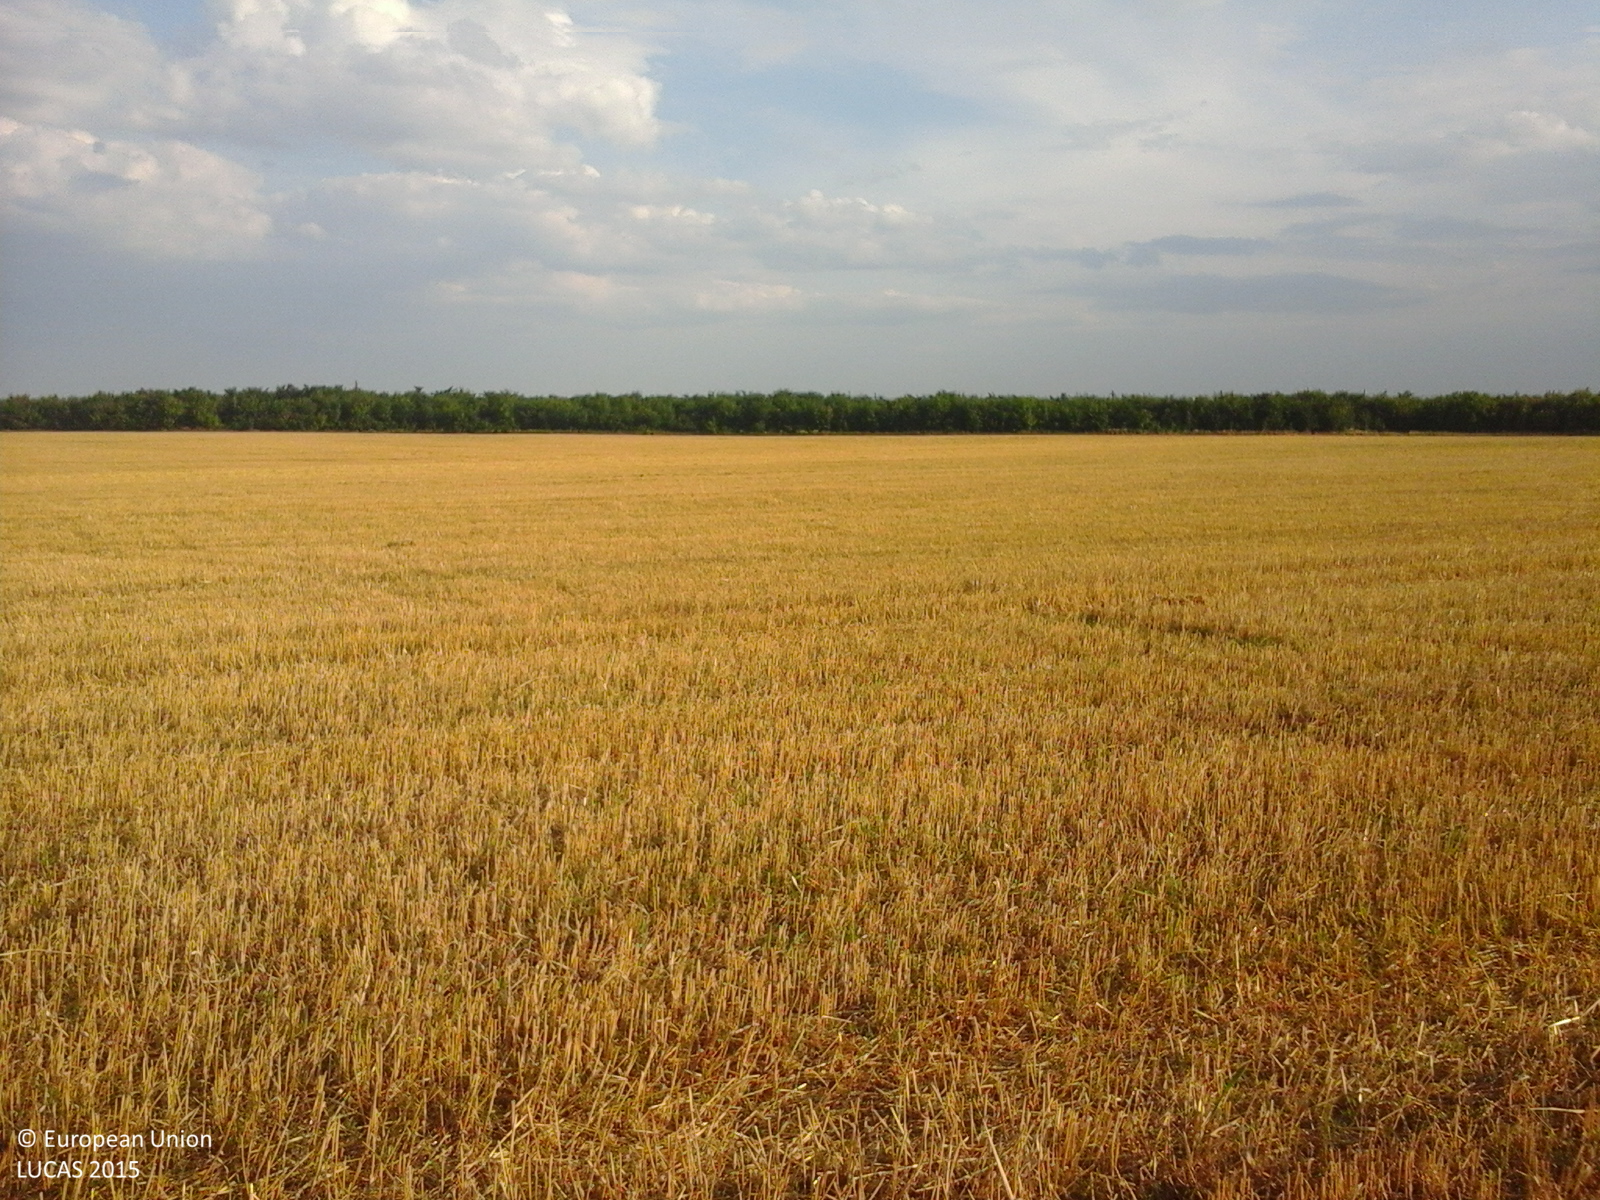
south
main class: Cropland
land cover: Common wheat
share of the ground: < 10 %
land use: Agriculture (excluding fallow land and kitchen gardens)
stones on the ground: < 10 %
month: June
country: RO
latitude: 44.4755
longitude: 26.2384
